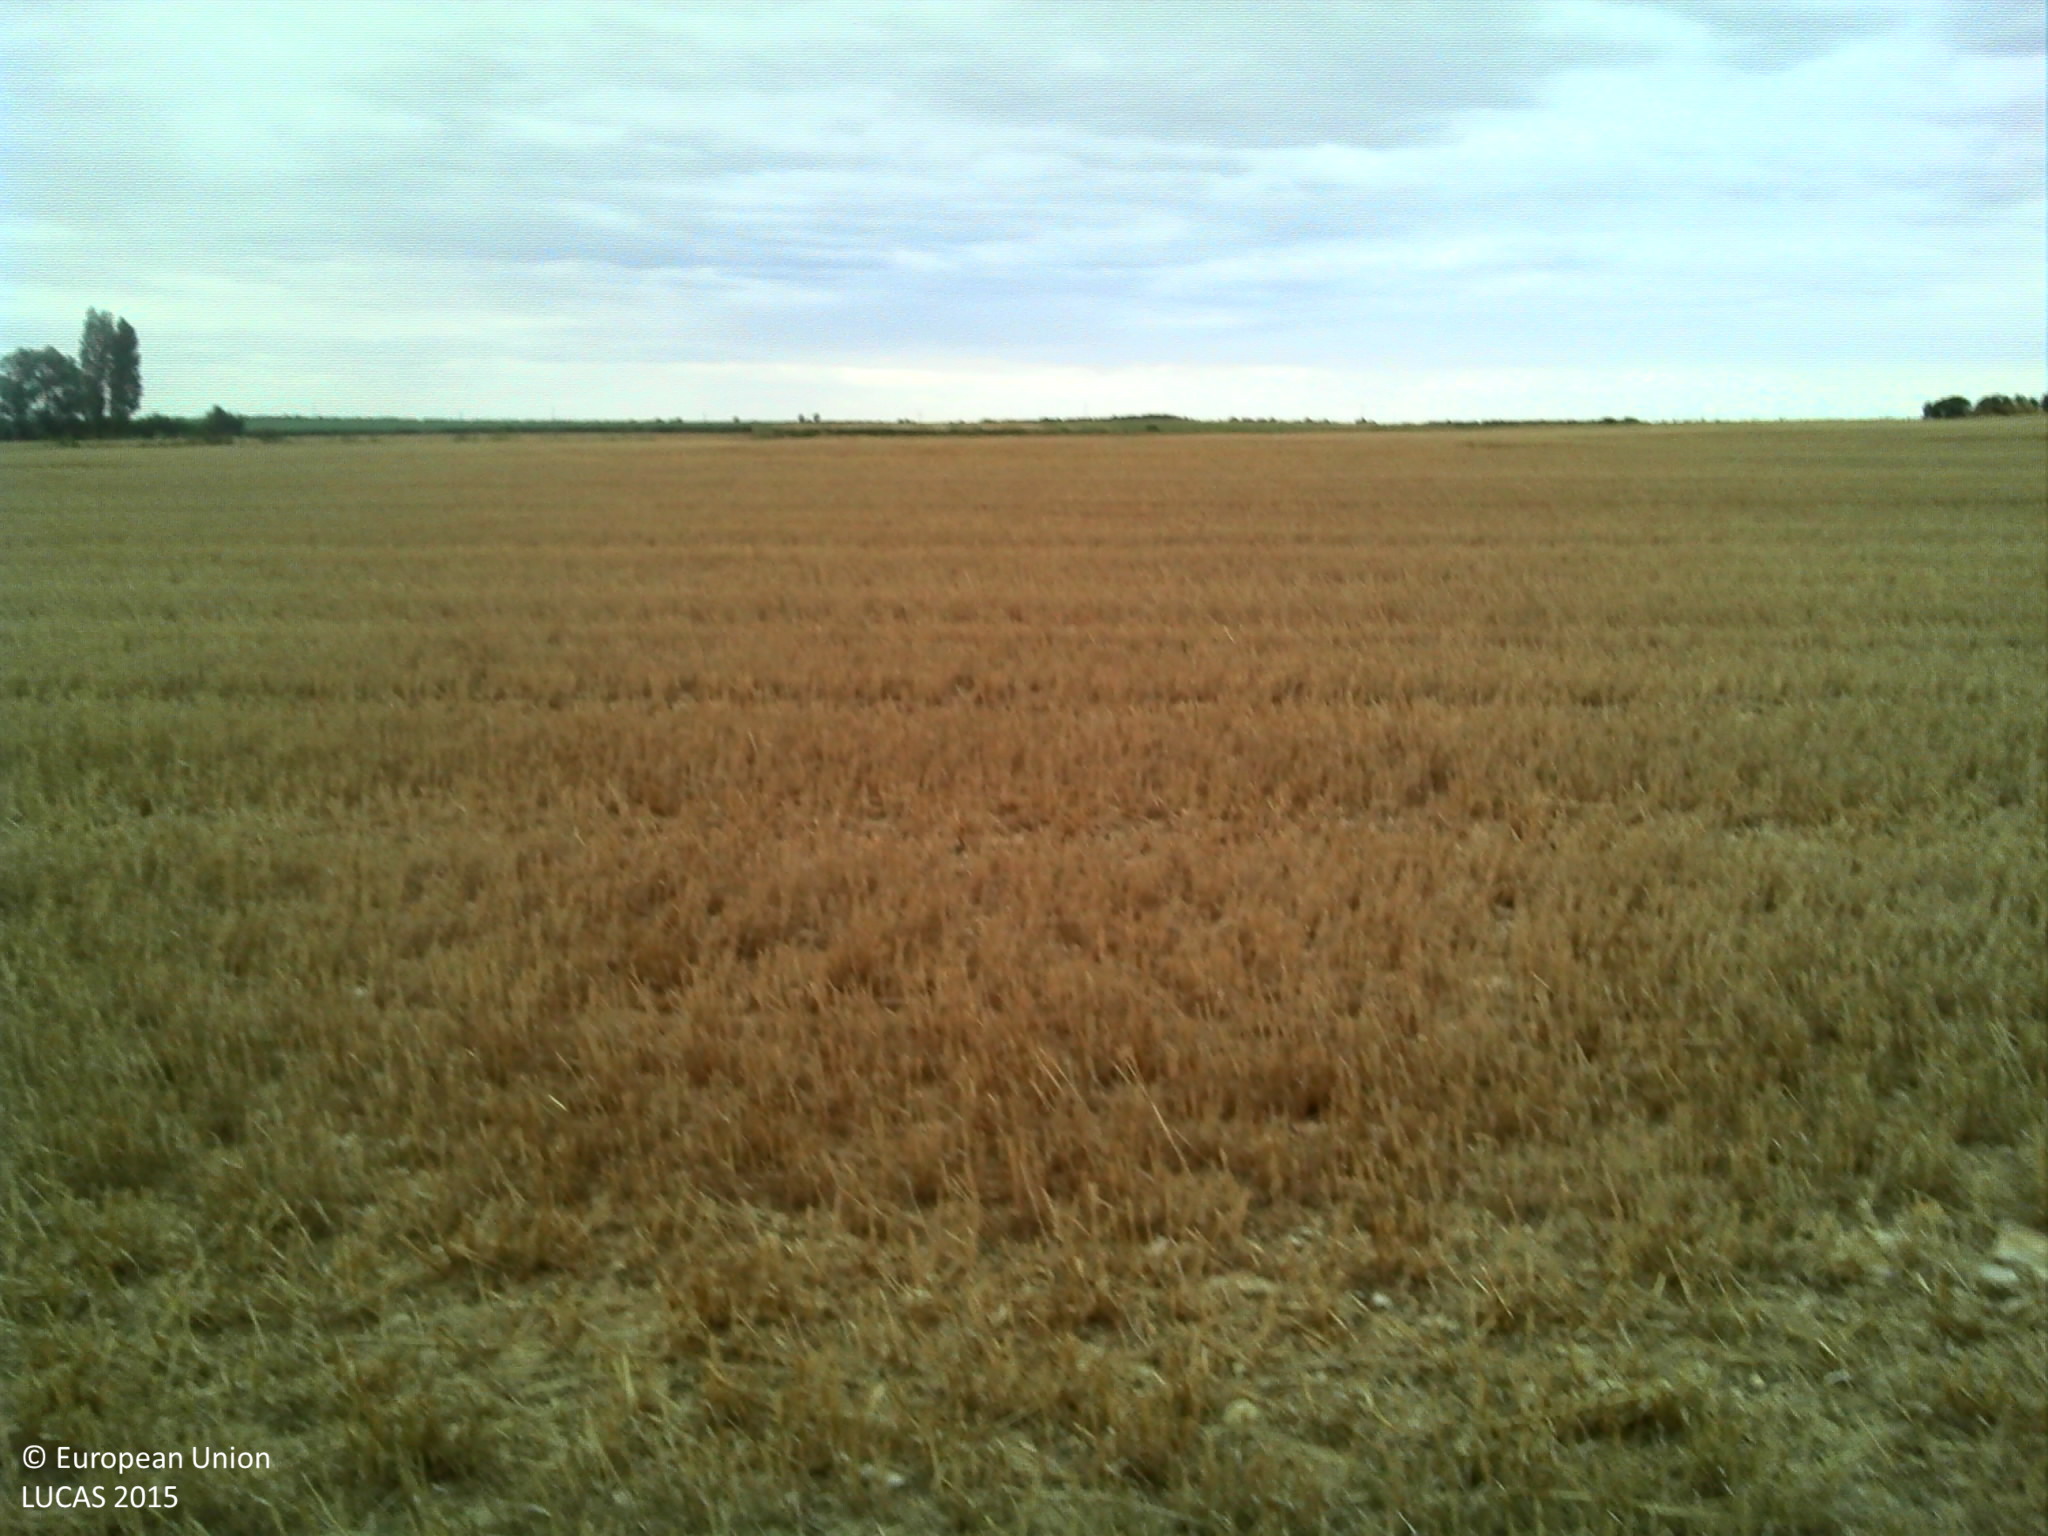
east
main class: Cropland
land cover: Common wheat
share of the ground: > 75 %
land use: Agriculture (excluding fallow land and kitchen gardens)
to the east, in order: Common wheat; Ditches and canals; Grass margins; Tracks; Grass margins; Ditches and canals; Barley
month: July
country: FR
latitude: 46.8310
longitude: 2.2711
